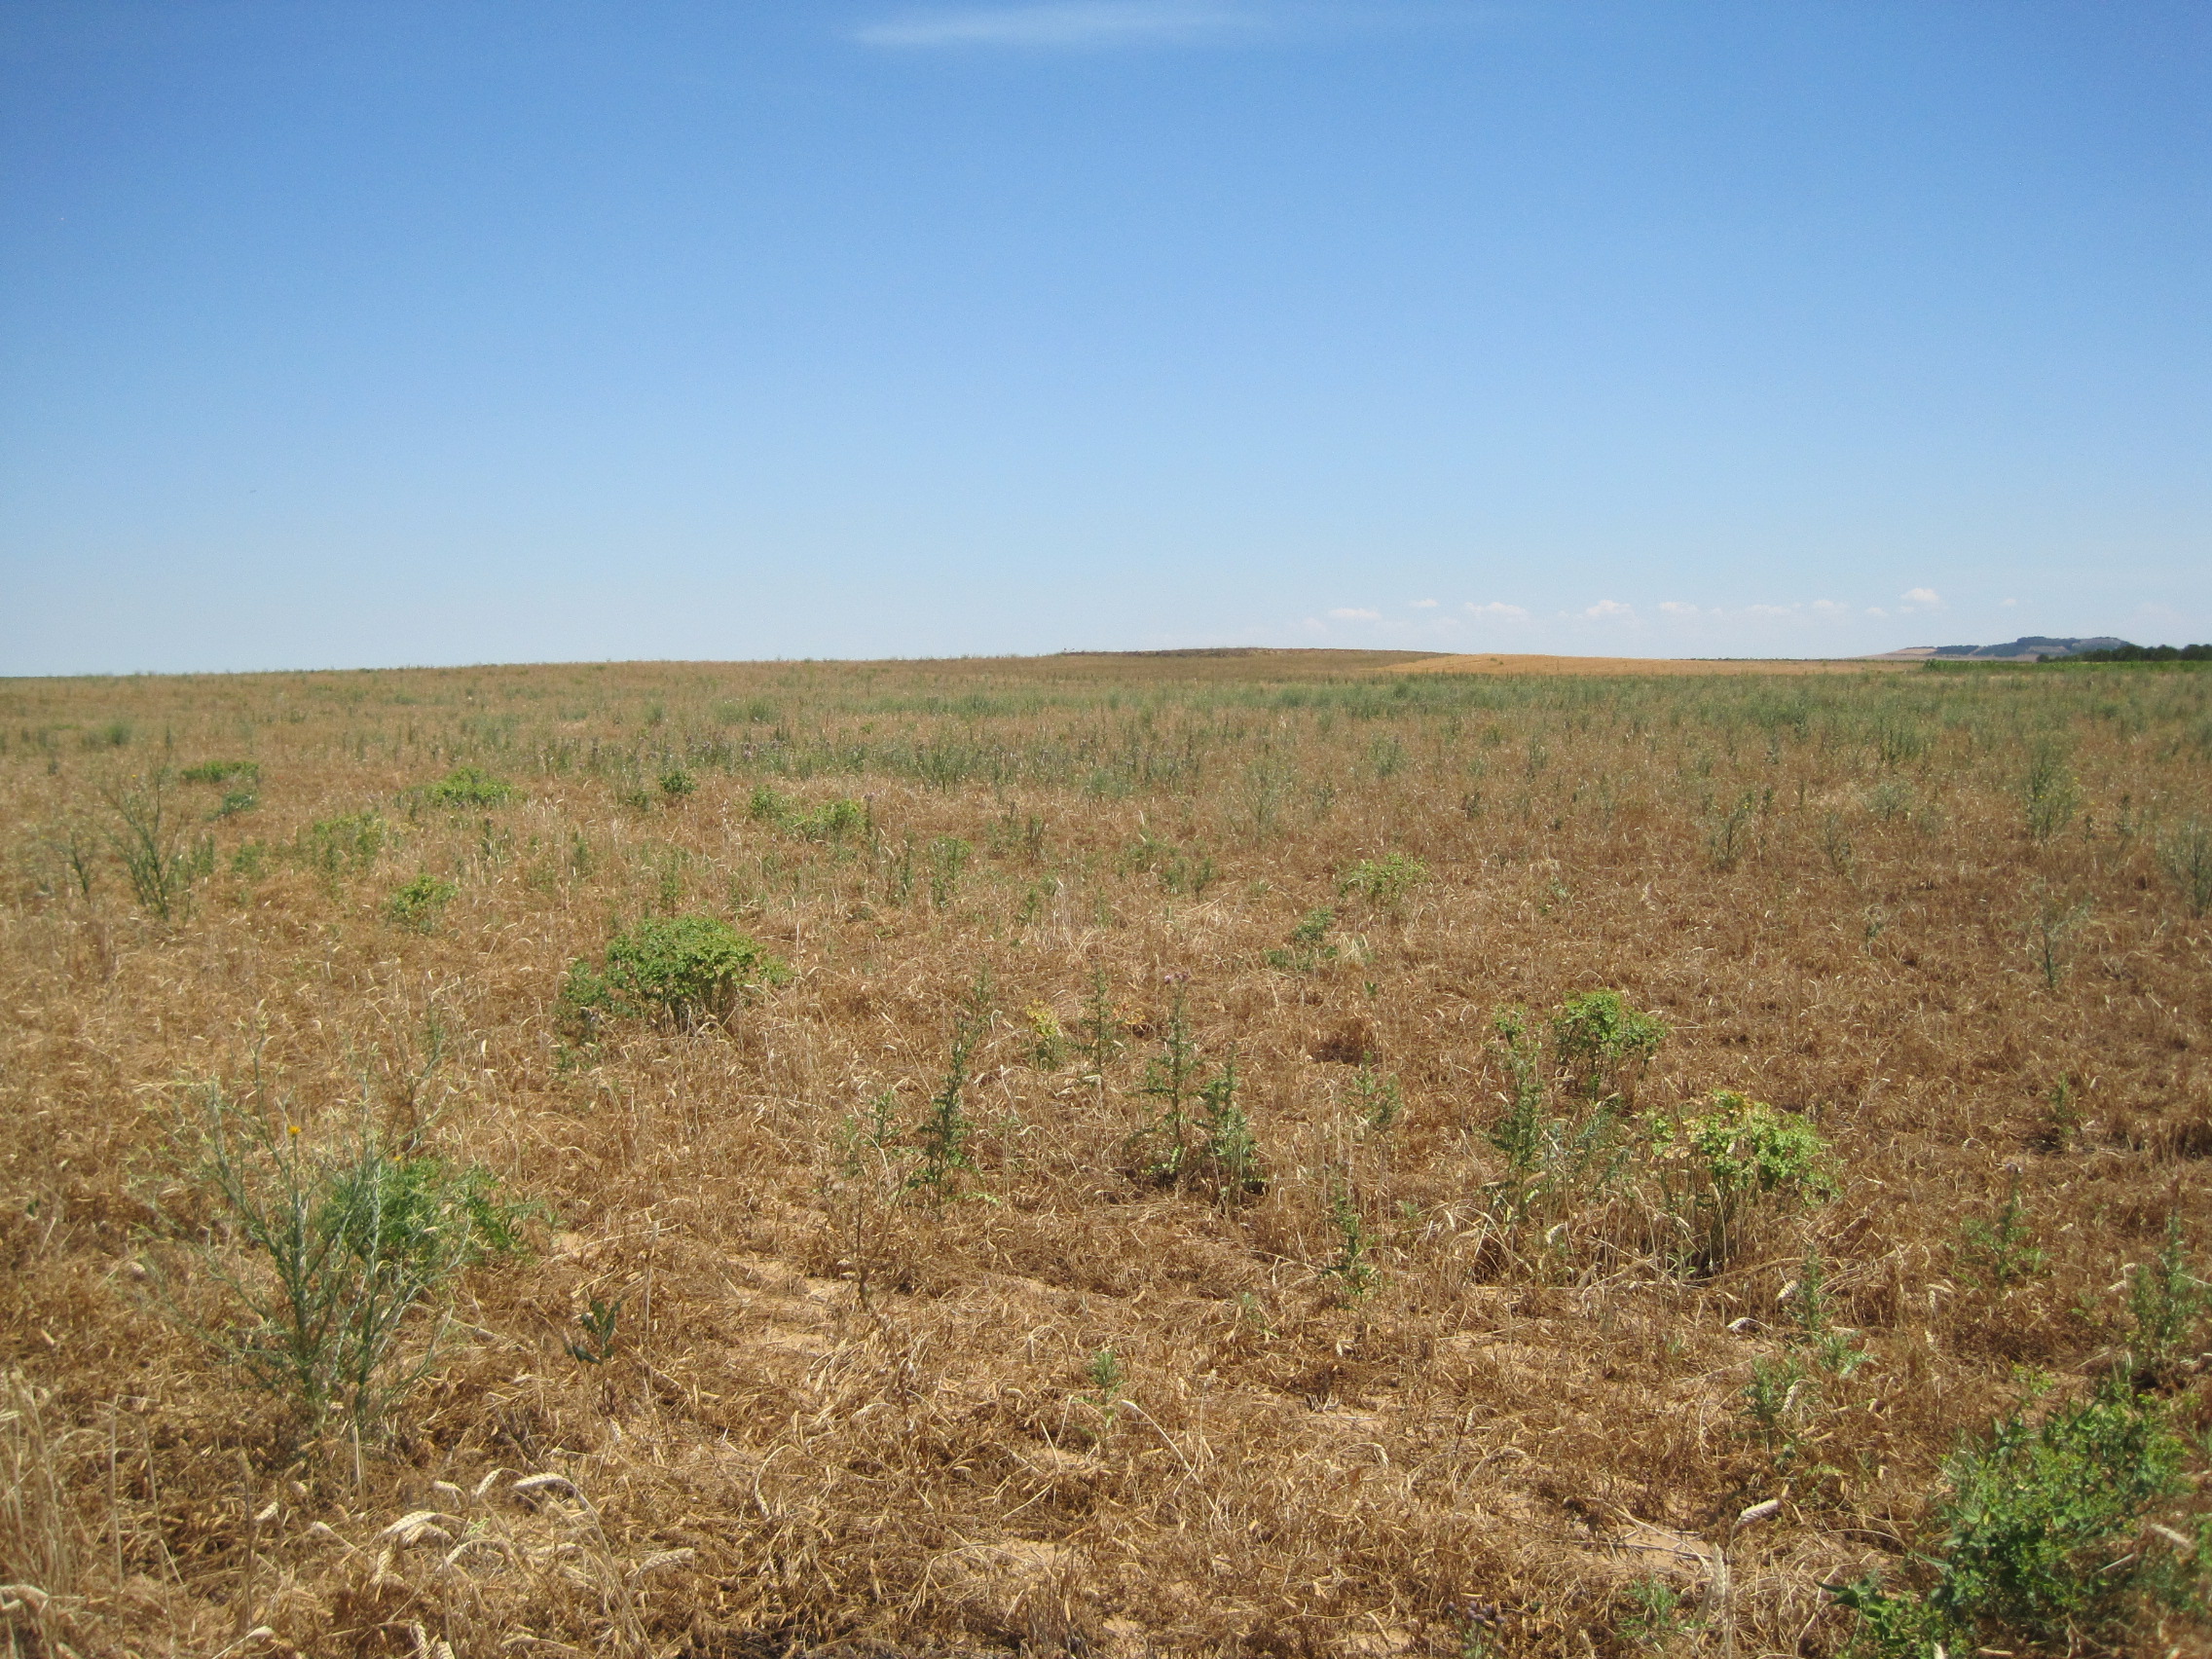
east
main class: Cropland
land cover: Dry pulses
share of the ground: 10 - 25 %
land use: Agriculture (excluding fallow land and kitchen gardens)
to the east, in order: Dry pulses; Grass margins; Dry pulses; Grass margins; Other bare soil
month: June
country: ES
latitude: 41.8411
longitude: -5.2430
